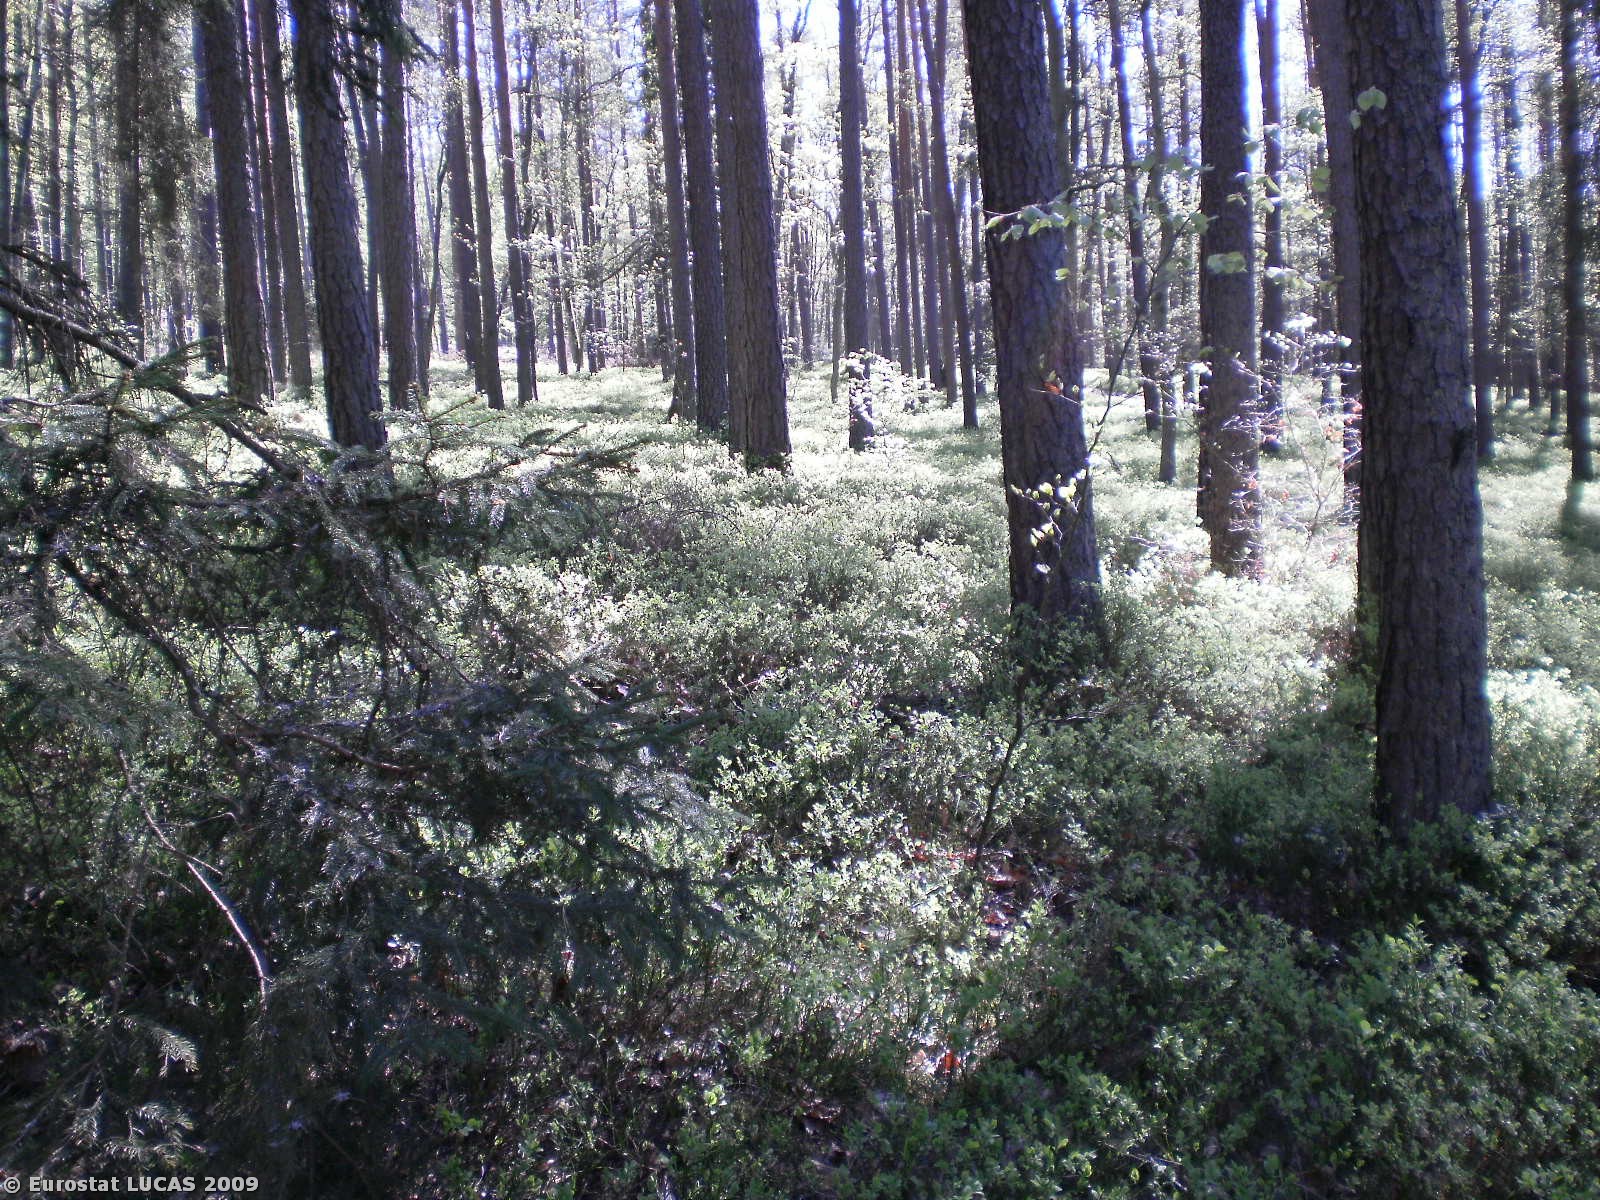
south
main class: Woodland
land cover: Coniferous woodland
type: hemiboreal forest and nemoral coniferous forest and mixed broadleaved-coniferous forest
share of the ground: > 75 %
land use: Forestry
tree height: > 5 m
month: January
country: PL
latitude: 53.9397
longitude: 18.9328
